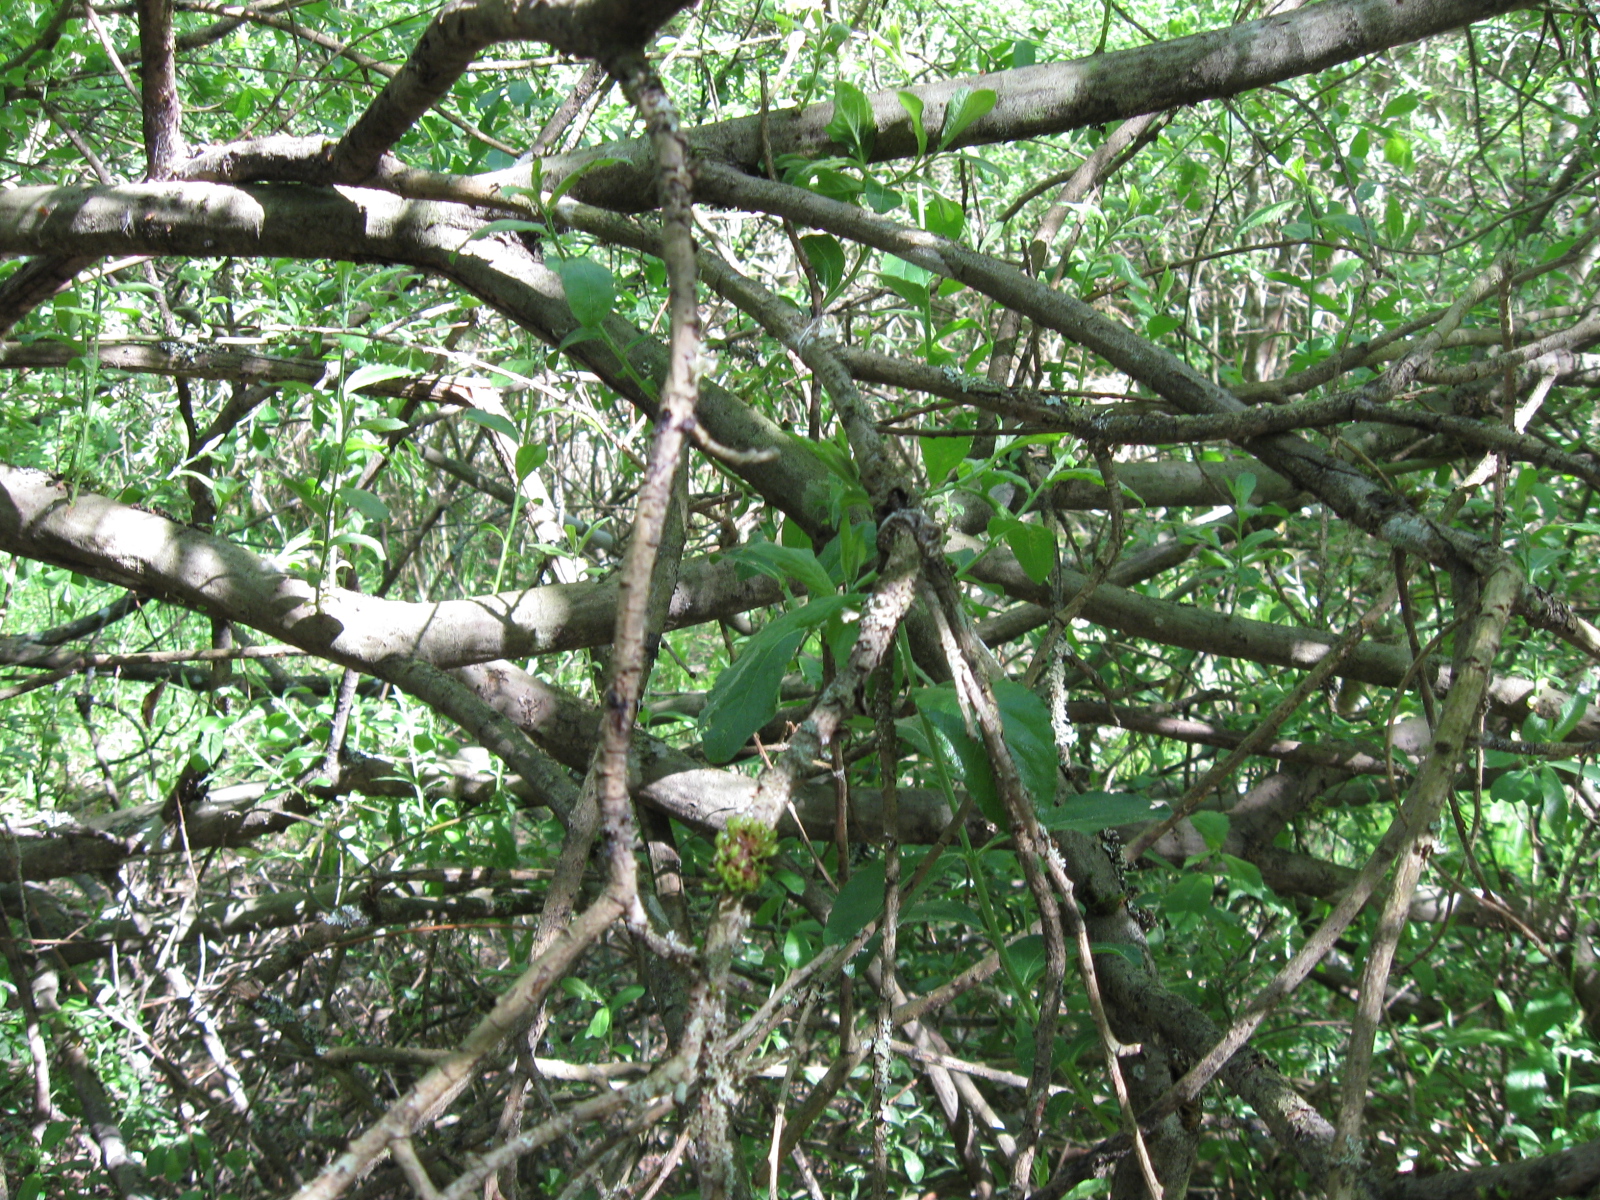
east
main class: Woodland
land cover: Spruce dominated mixed woodland
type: hemiboreal forest and nemoral coniferous forest and mixed broadleaved-coniferous forest
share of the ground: > 75 %
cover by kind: broadleaved forest trees 65 %, coniferous forest trees 30 %, herbaceous plants 5 %
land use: Forestry
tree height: > 5 m
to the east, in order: Spruce dominated mixed woodland; Other mixed woodland; Broadleaved woodland; Other mixed woodland; Tracks; Other mixed woodland
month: June
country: LT
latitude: 54.1058
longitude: 23.6207
